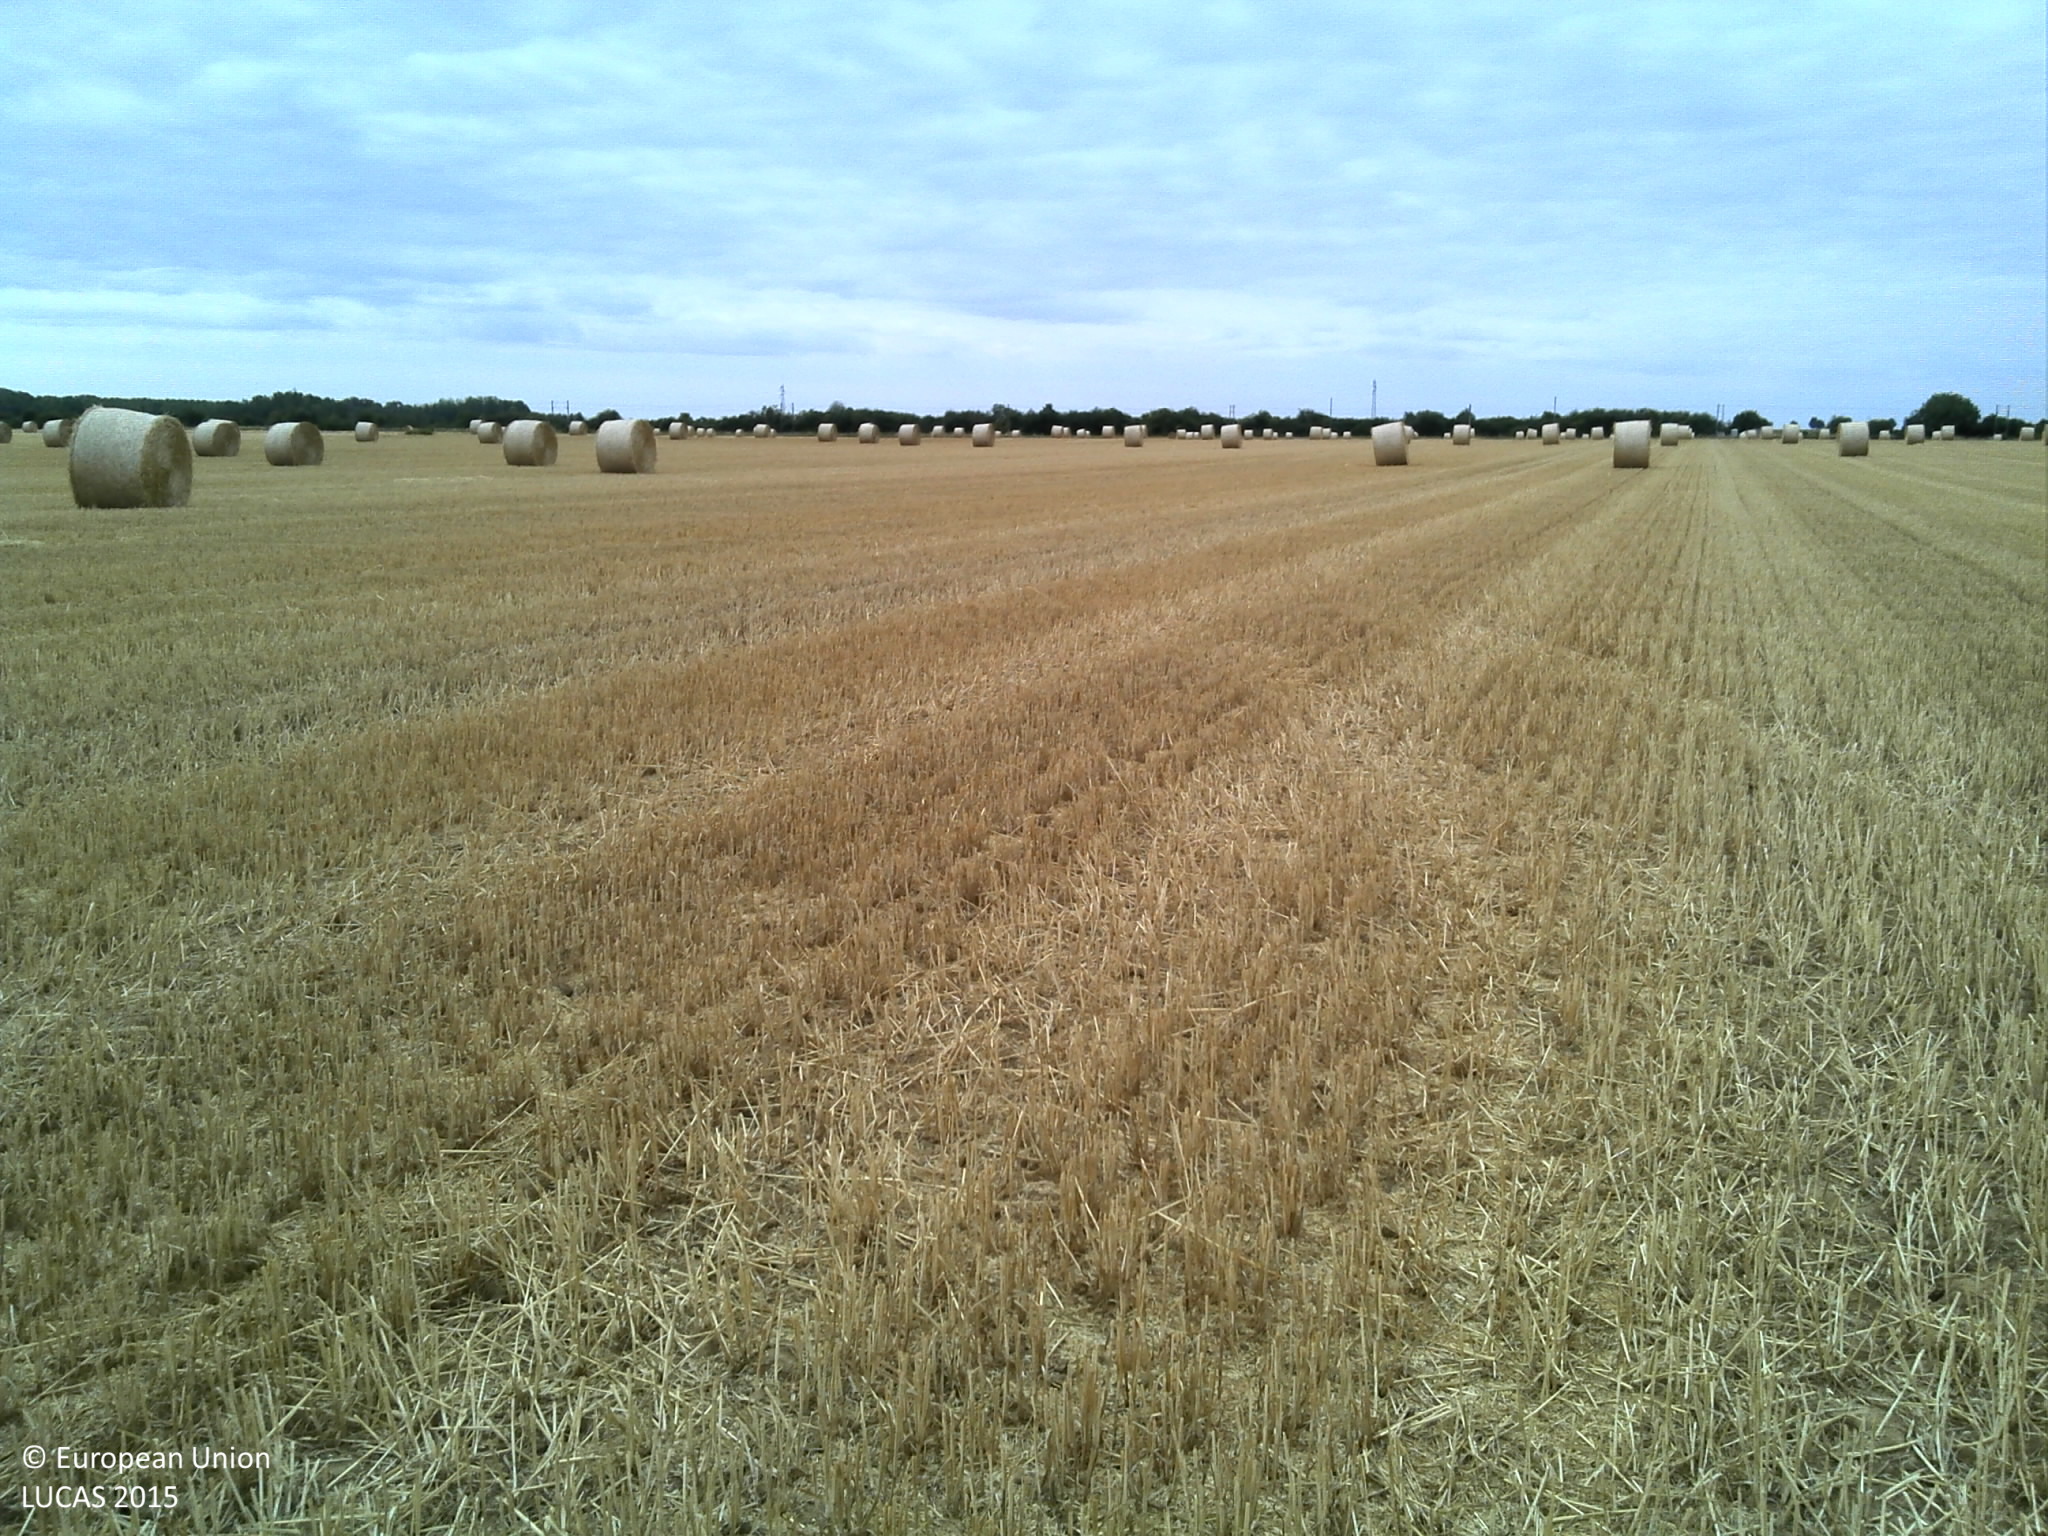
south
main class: Cropland
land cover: Common wheat
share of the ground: > 75 %
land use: Agriculture (excluding fallow land and kitchen gardens)
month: July
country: FR
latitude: 48.7263
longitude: 4.6820
